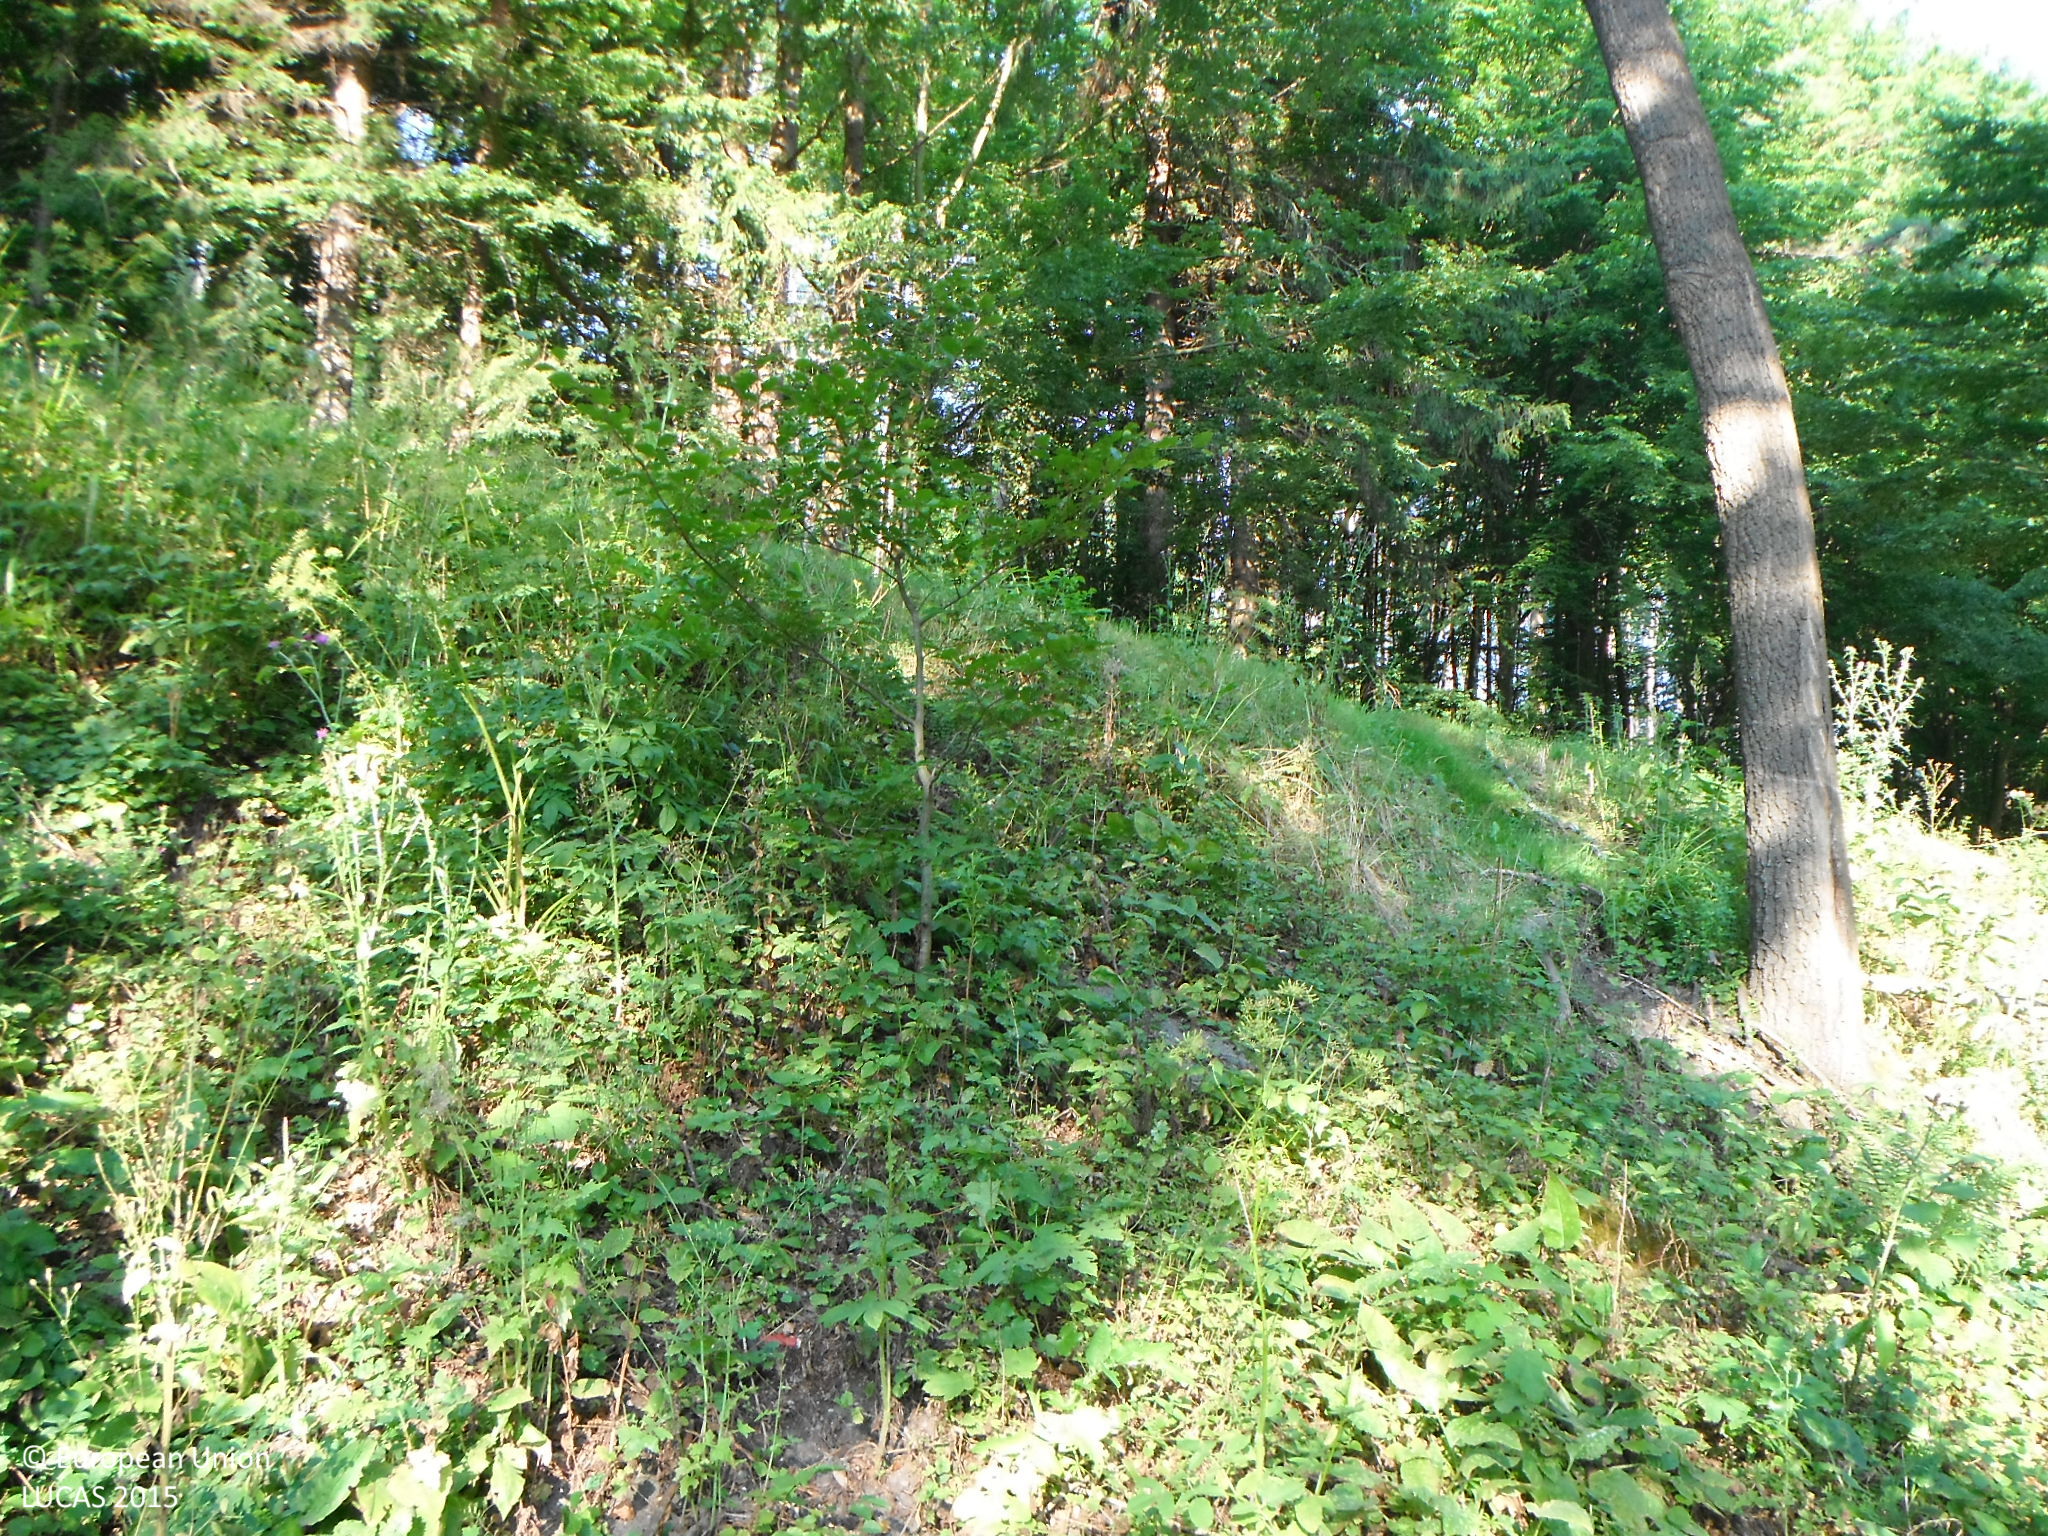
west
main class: Woodland
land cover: Broadleaved woodland
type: mountainous beech forest
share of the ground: 50 - 75 %
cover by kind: broadleaved forest trees 90 %, coniferous forest trees 5 %, herbaceous plants 5 %
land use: Forestry
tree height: > 5 m
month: August
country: SK
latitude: 48.3978
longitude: 19.2201
